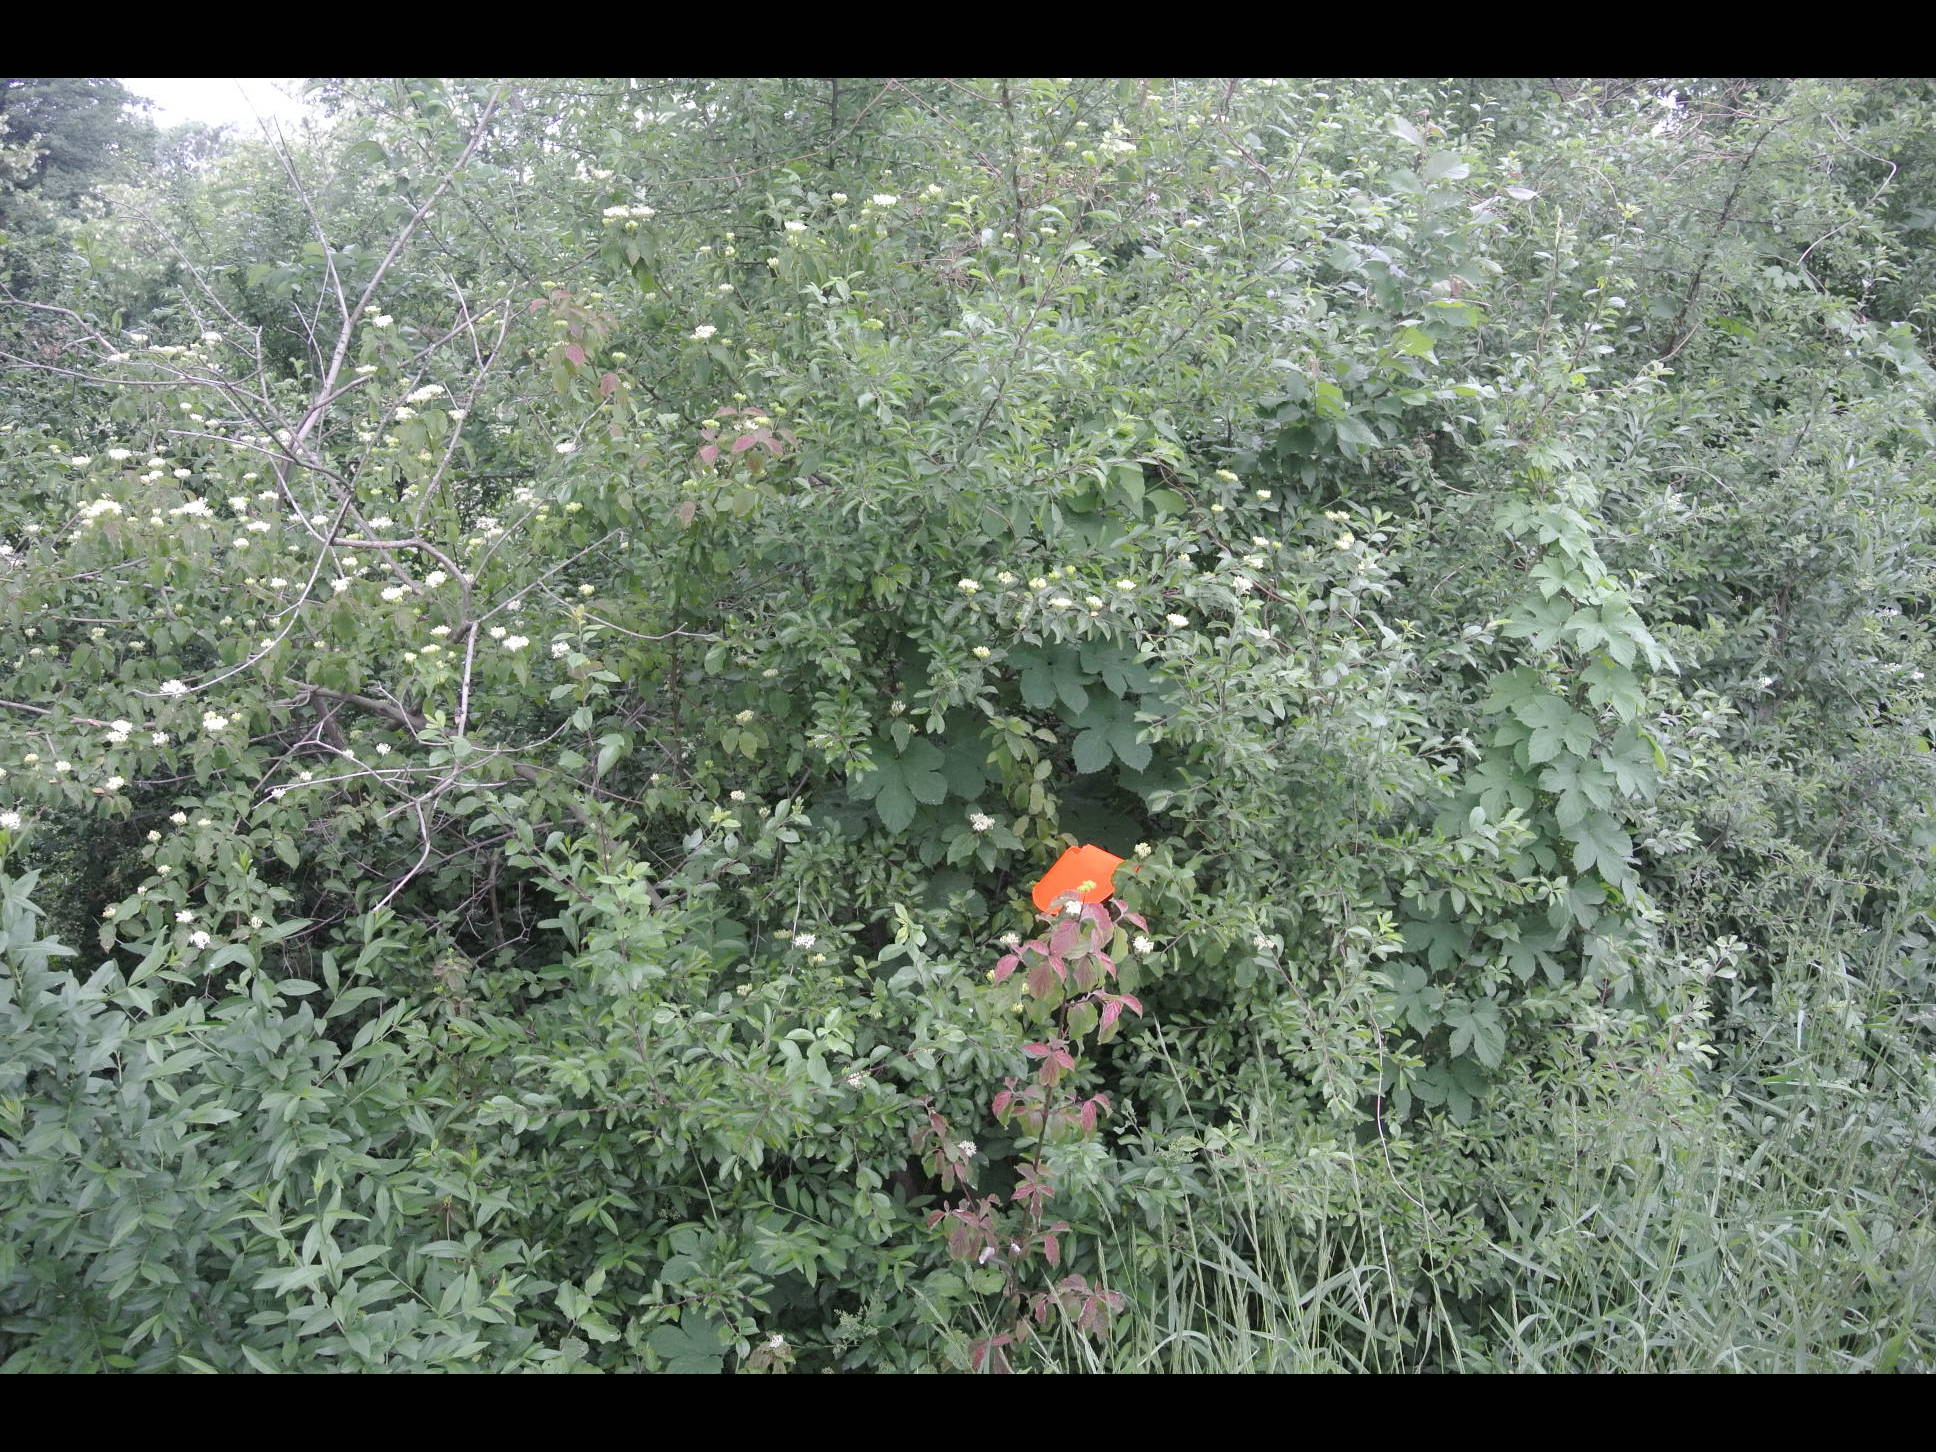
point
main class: Woodland
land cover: Broadleaved woodland
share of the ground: > 75 %
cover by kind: broadleaved forest trees 85 %, shrubs 15 %
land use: Semi-natural and natural areas not in use
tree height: > 5 m
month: May
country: AT
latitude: 48.0164
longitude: 16.4536
